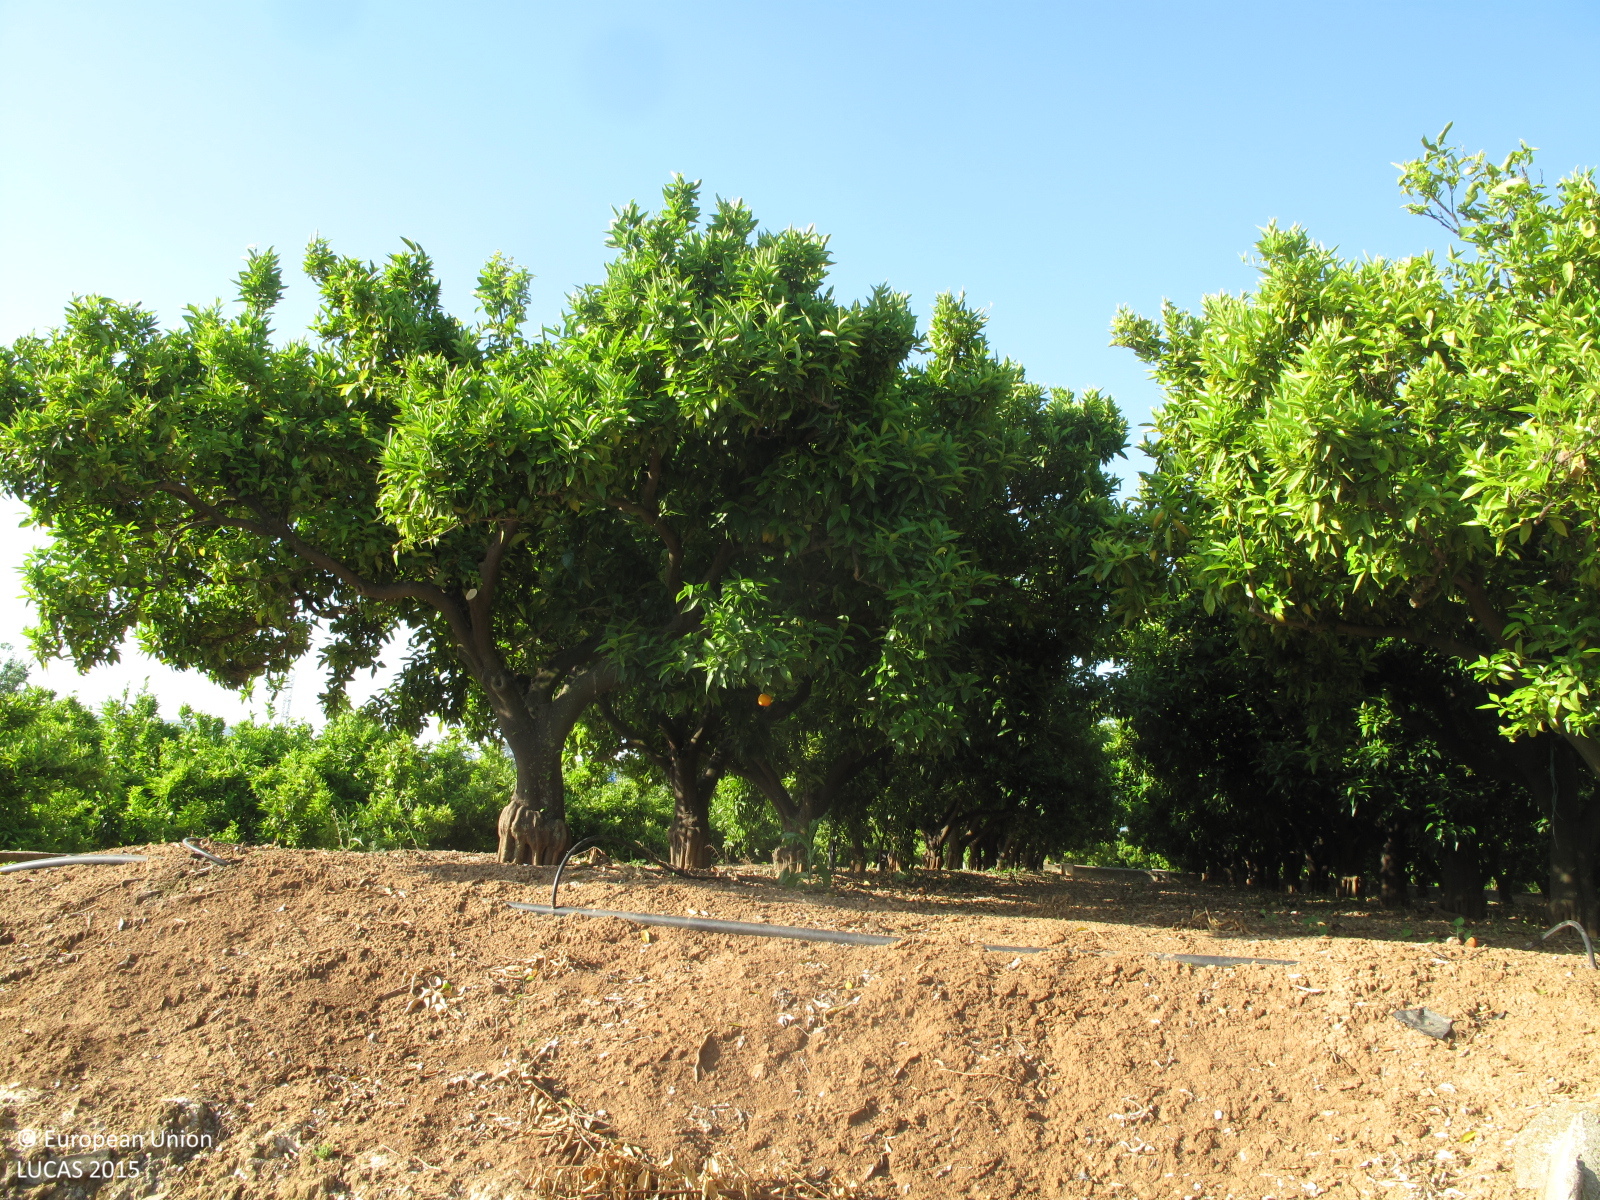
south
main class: Cropland
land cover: Oranges
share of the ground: > 75 %
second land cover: Spontaneously vegetated surfaces
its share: 25 - 50 %
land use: Agriculture (excluding fallow land and kitchen gardens)
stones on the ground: < 10 %
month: May
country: ES
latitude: 39.0002
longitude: -0.5815
